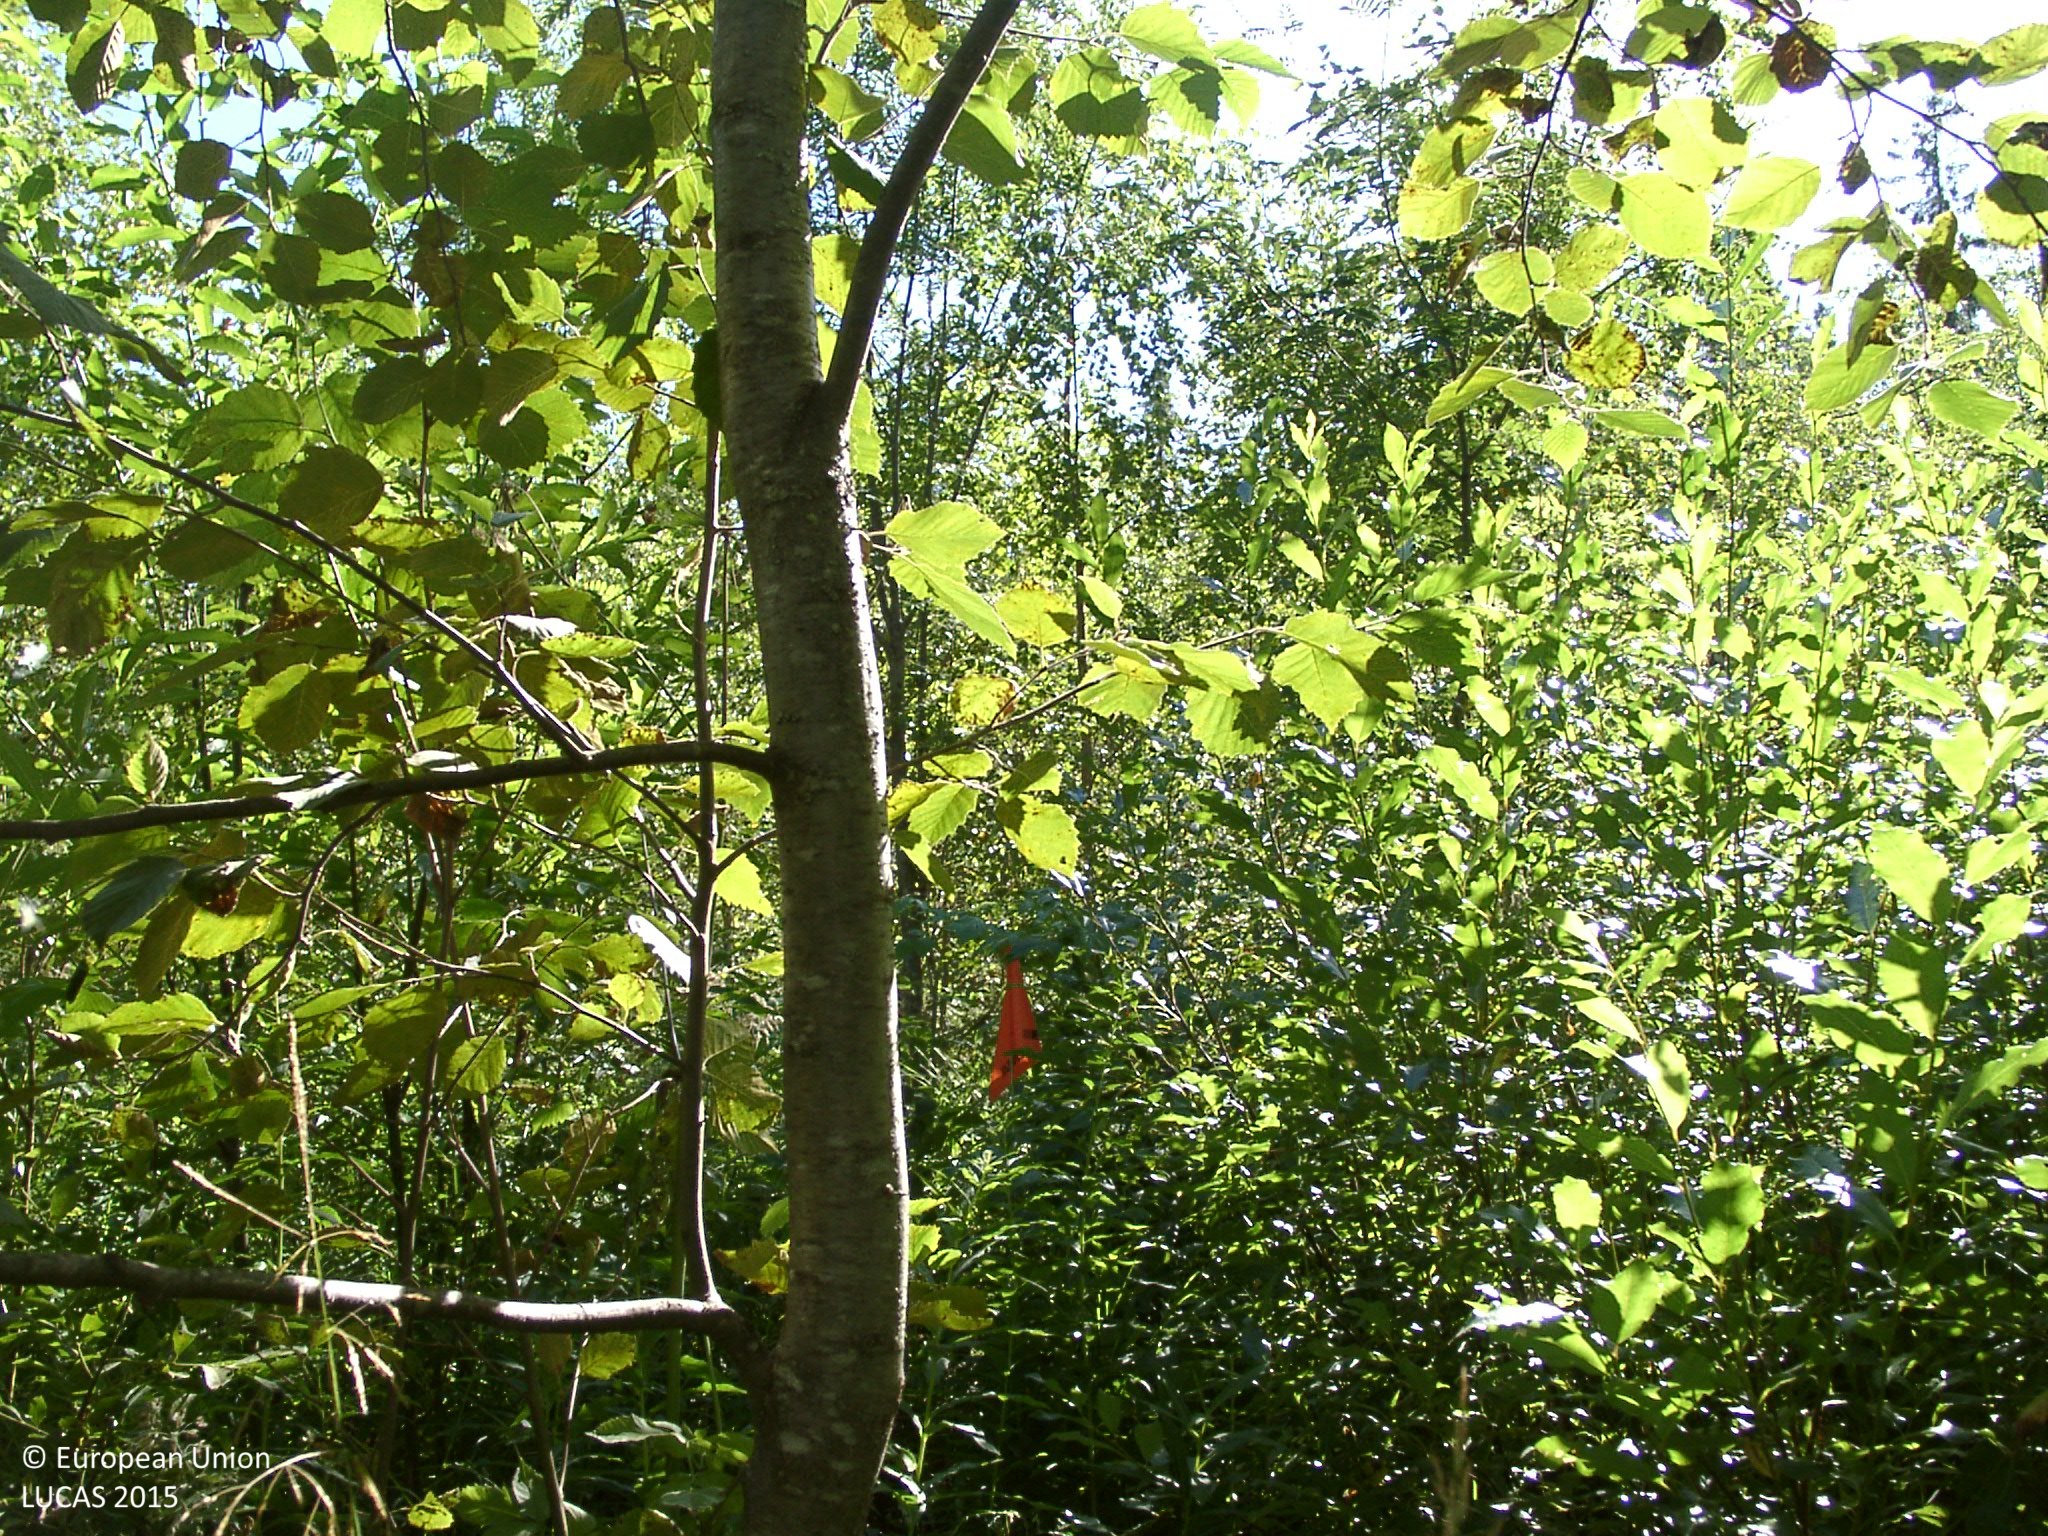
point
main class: Woodland
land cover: Broadleaved woodland
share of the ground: 50 - 75 %
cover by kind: broadleaved forest trees 60 %, shrubs 20 %, herbaceous plants 20 %
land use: Forestry
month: August
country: FI
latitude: 62.3703
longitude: 25.3601
